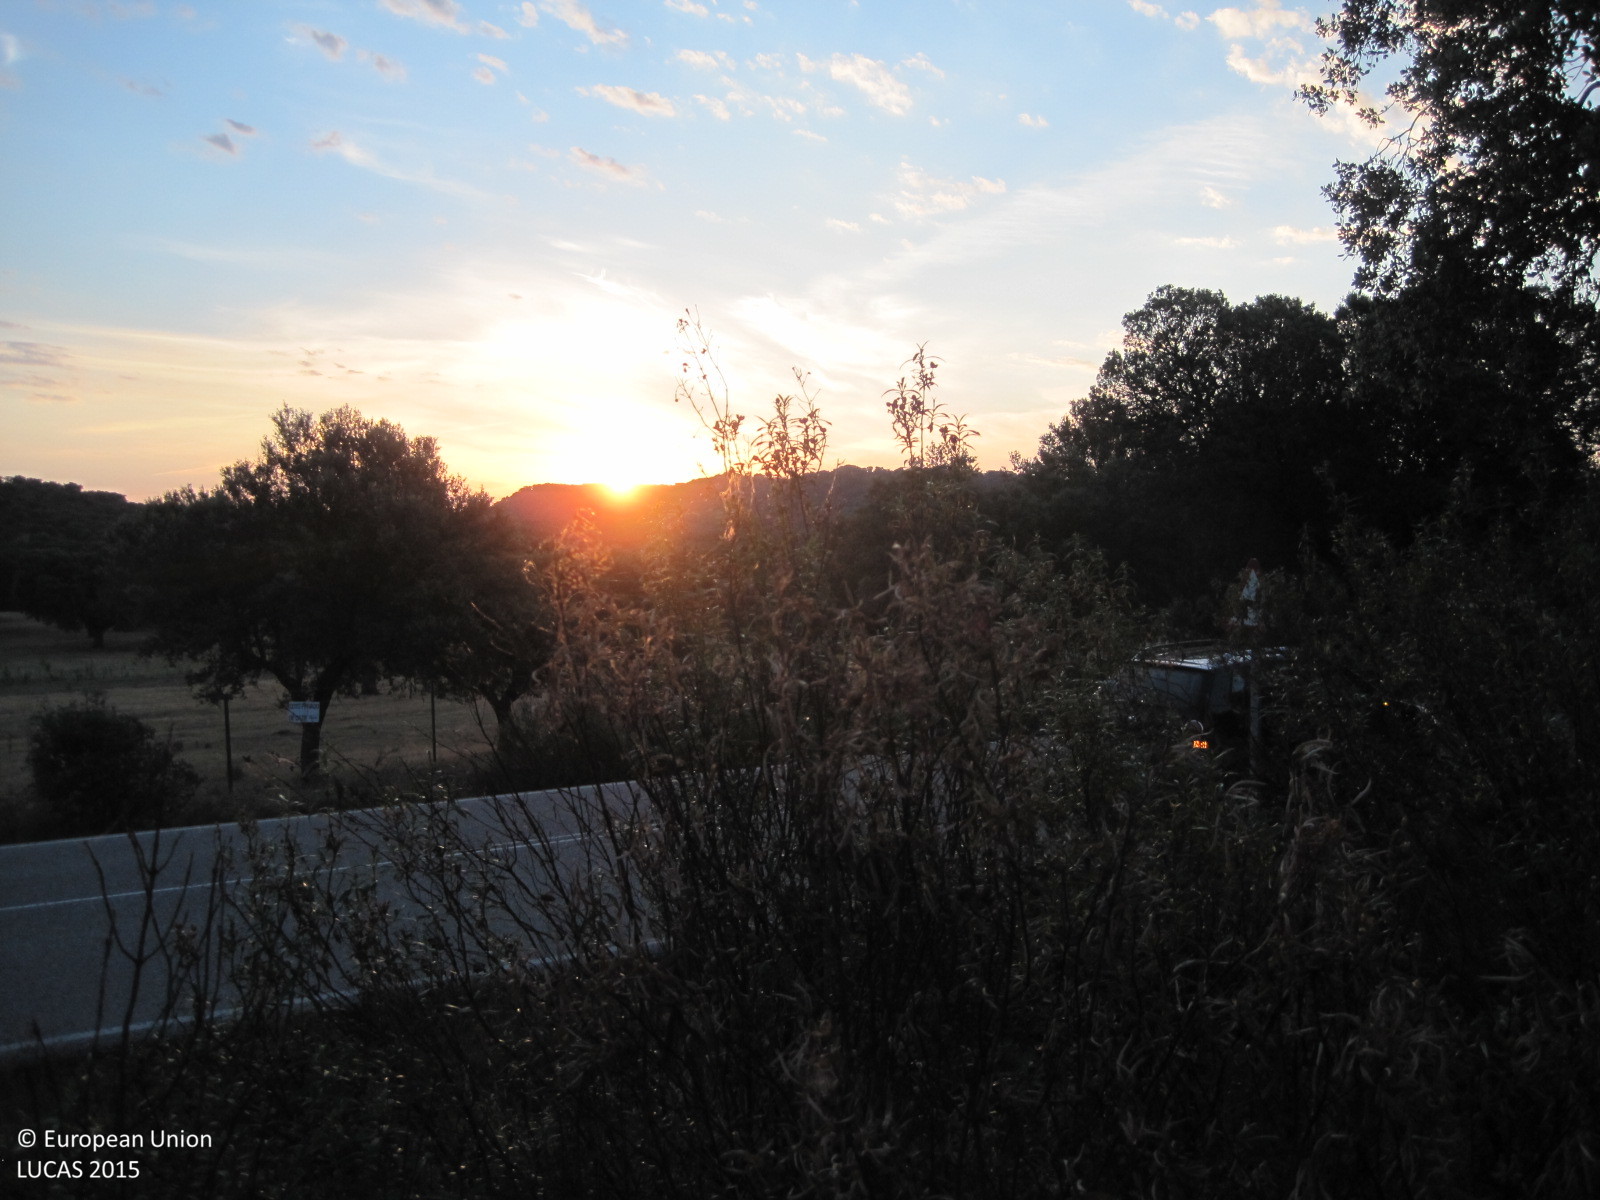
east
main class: Woodland
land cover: Broadleaved woodland
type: broadleaved evergreen forest
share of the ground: > 75 %
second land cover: Shrubland without tree cover
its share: 50 - 75 %
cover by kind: broadleaved forest trees 75 %, shrubs 20 %, herbaceous plants 5 %
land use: Forestry
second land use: Agriculture (excluding fallow land and kitchen gardens)
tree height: < 5 m
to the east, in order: Broadleaved woodland; Shrubland without tree cover; Other bare soil; Electric lines; Other bare soil; Fences; Shrubland with sparse tree cover; Grass margins; Paved roads, cycling and walking lanes; Grass margins; Shrubland with sparse tree cover; Fences; Grassland without tree/shrub cover; Tracks; Grassland without tree/shrub cover
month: June
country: ES
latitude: 40.0544
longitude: -5.1651
